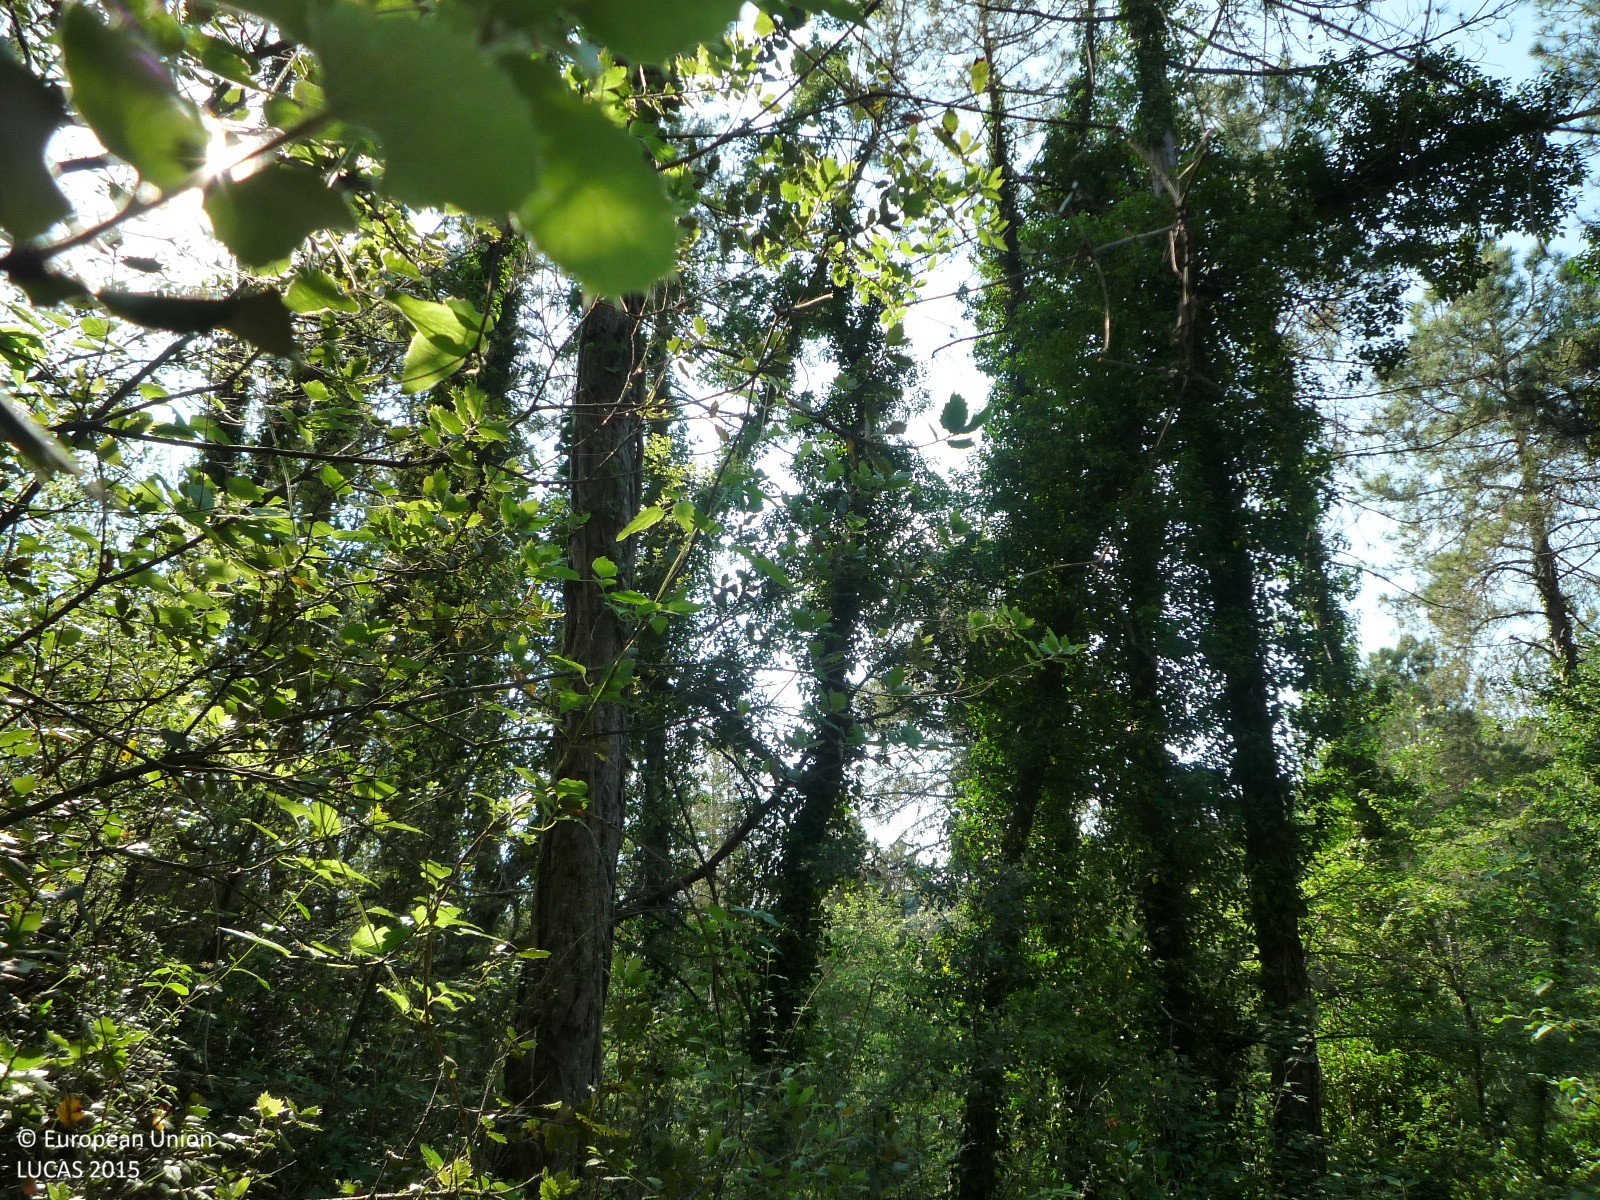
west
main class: Woodland
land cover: Pine dominated mixed woodland
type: coniferous forest of the mediterranean region
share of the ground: > 75 %
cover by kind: coniferous forest trees 70 %, broadleaved forest trees 30 %
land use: Semi-natural and natural areas not in use
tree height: > 5 m
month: May
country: ES
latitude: 41.9016
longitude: 1.9984
